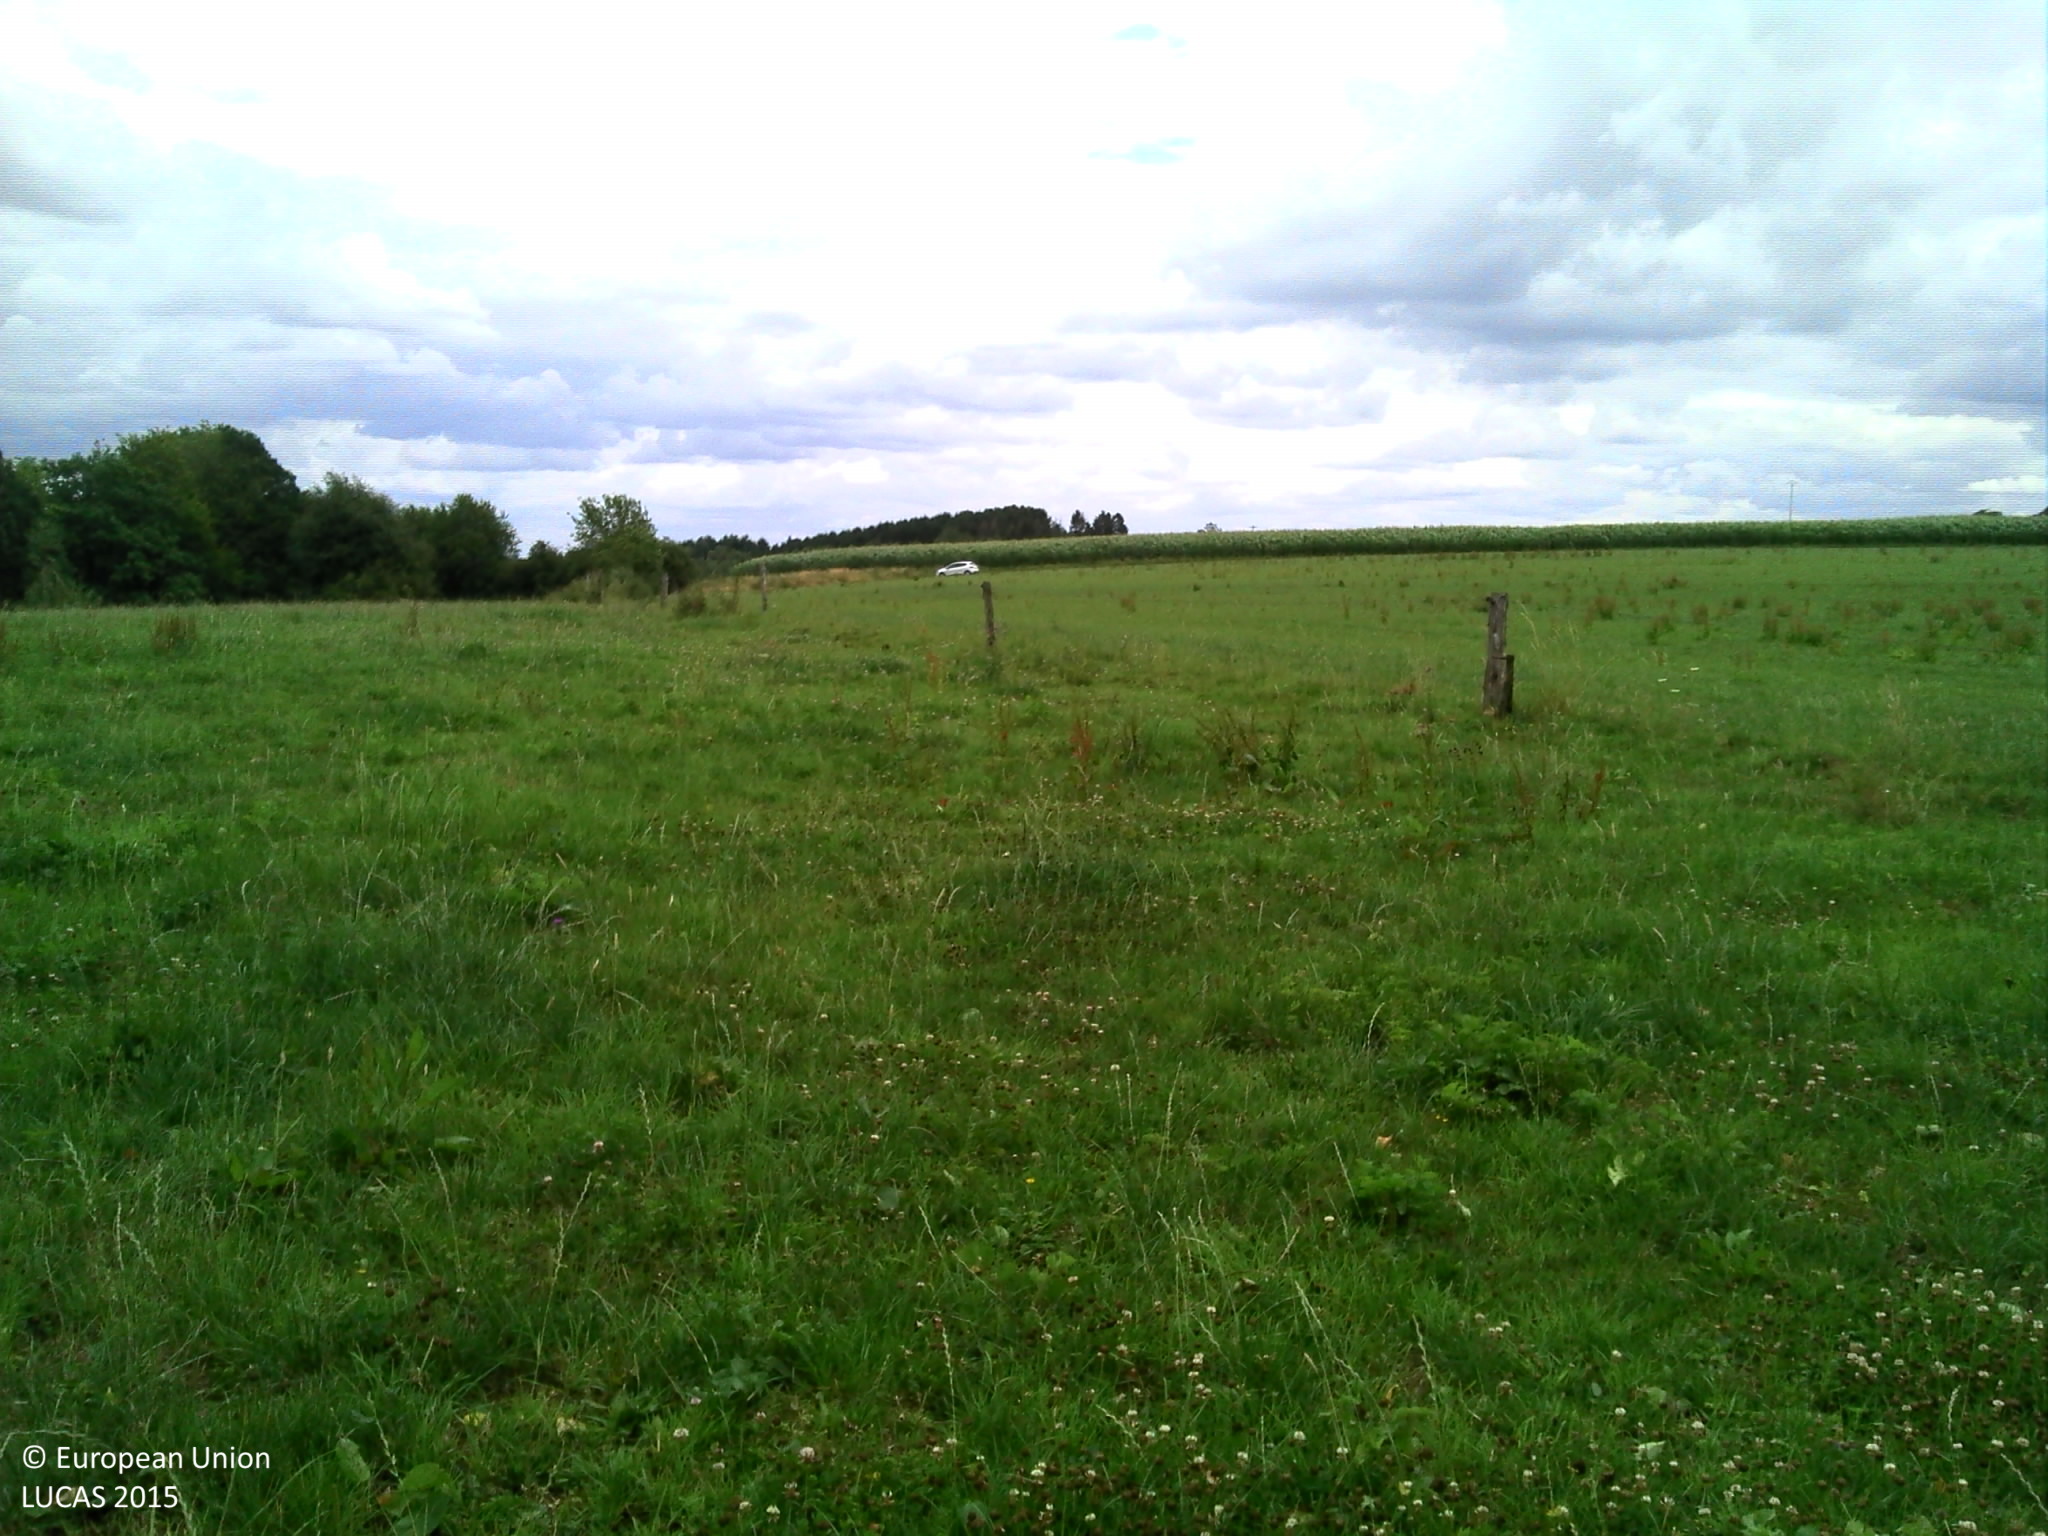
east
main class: Grassland
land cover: Grassland without tree/shrub cover
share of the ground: > 75 %
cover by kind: herbaceous plants 100 %
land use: Agriculture (excluding fallow land and kitchen gardens)
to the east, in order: Grassland without tree/shrub cover; Fences; Grassland without tree/shrub cover; Tracks; Grass margins; Maize
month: July
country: BE
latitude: 49.6167
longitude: 5.6942
